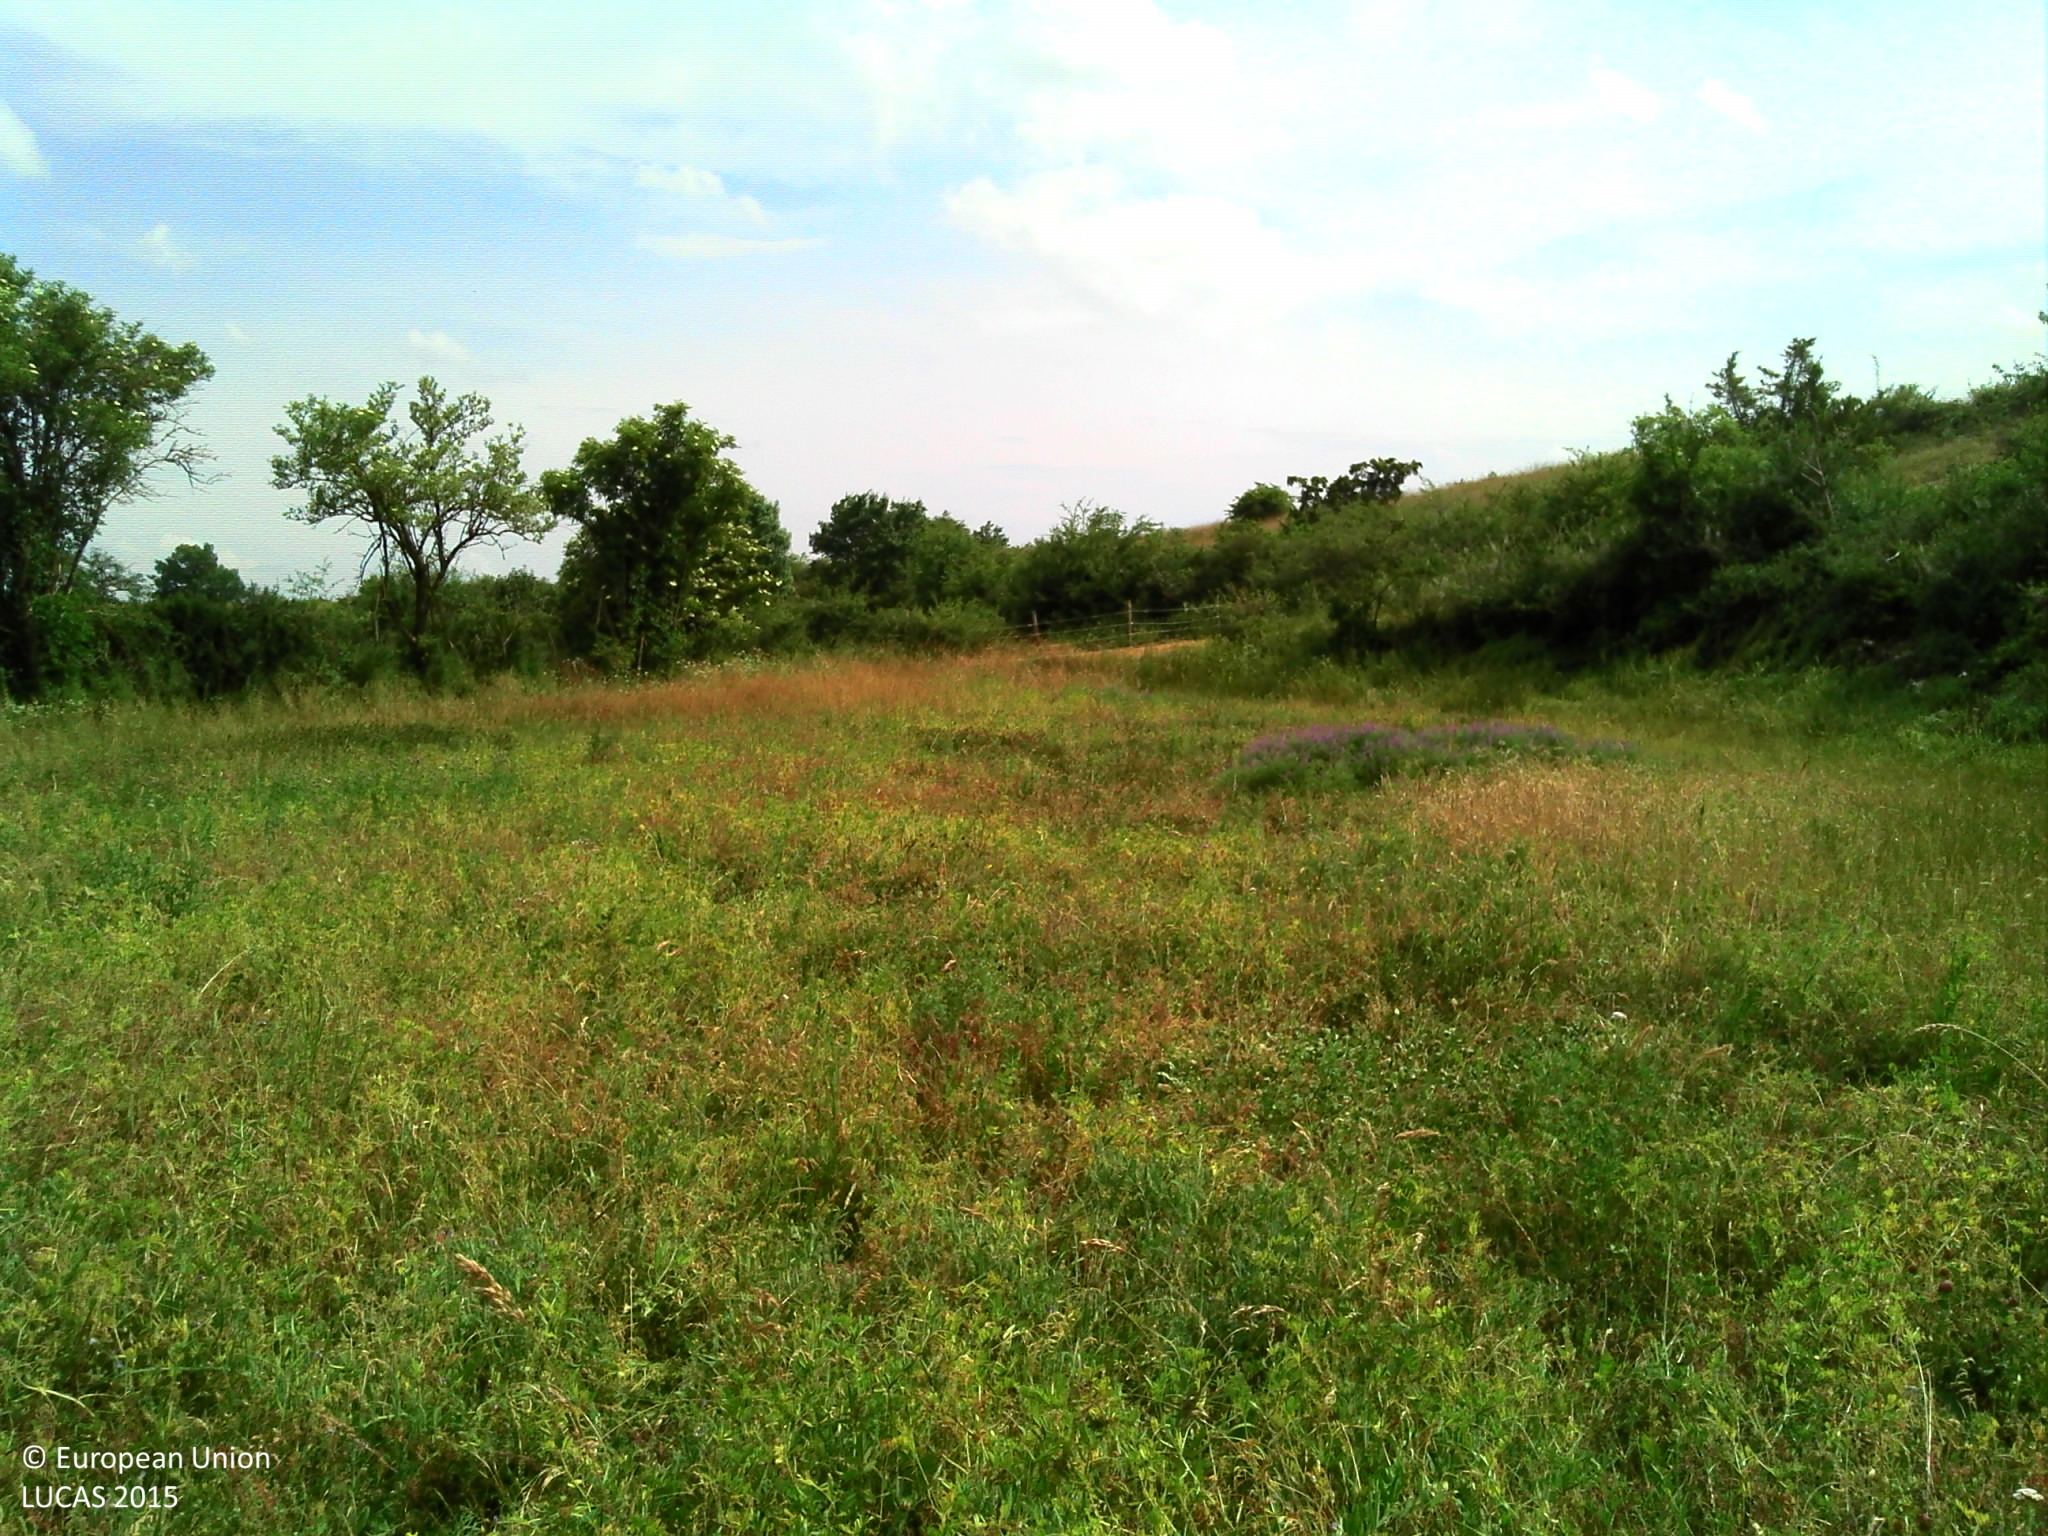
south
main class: Grassland
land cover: Spontaneously vegetated surfaces
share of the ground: > 75 %
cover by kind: herbaceous plants 95 %, shrubs 5 %
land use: Fallow land
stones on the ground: > 50 %
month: June
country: FR
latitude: 44.4824
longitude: 2.5721
